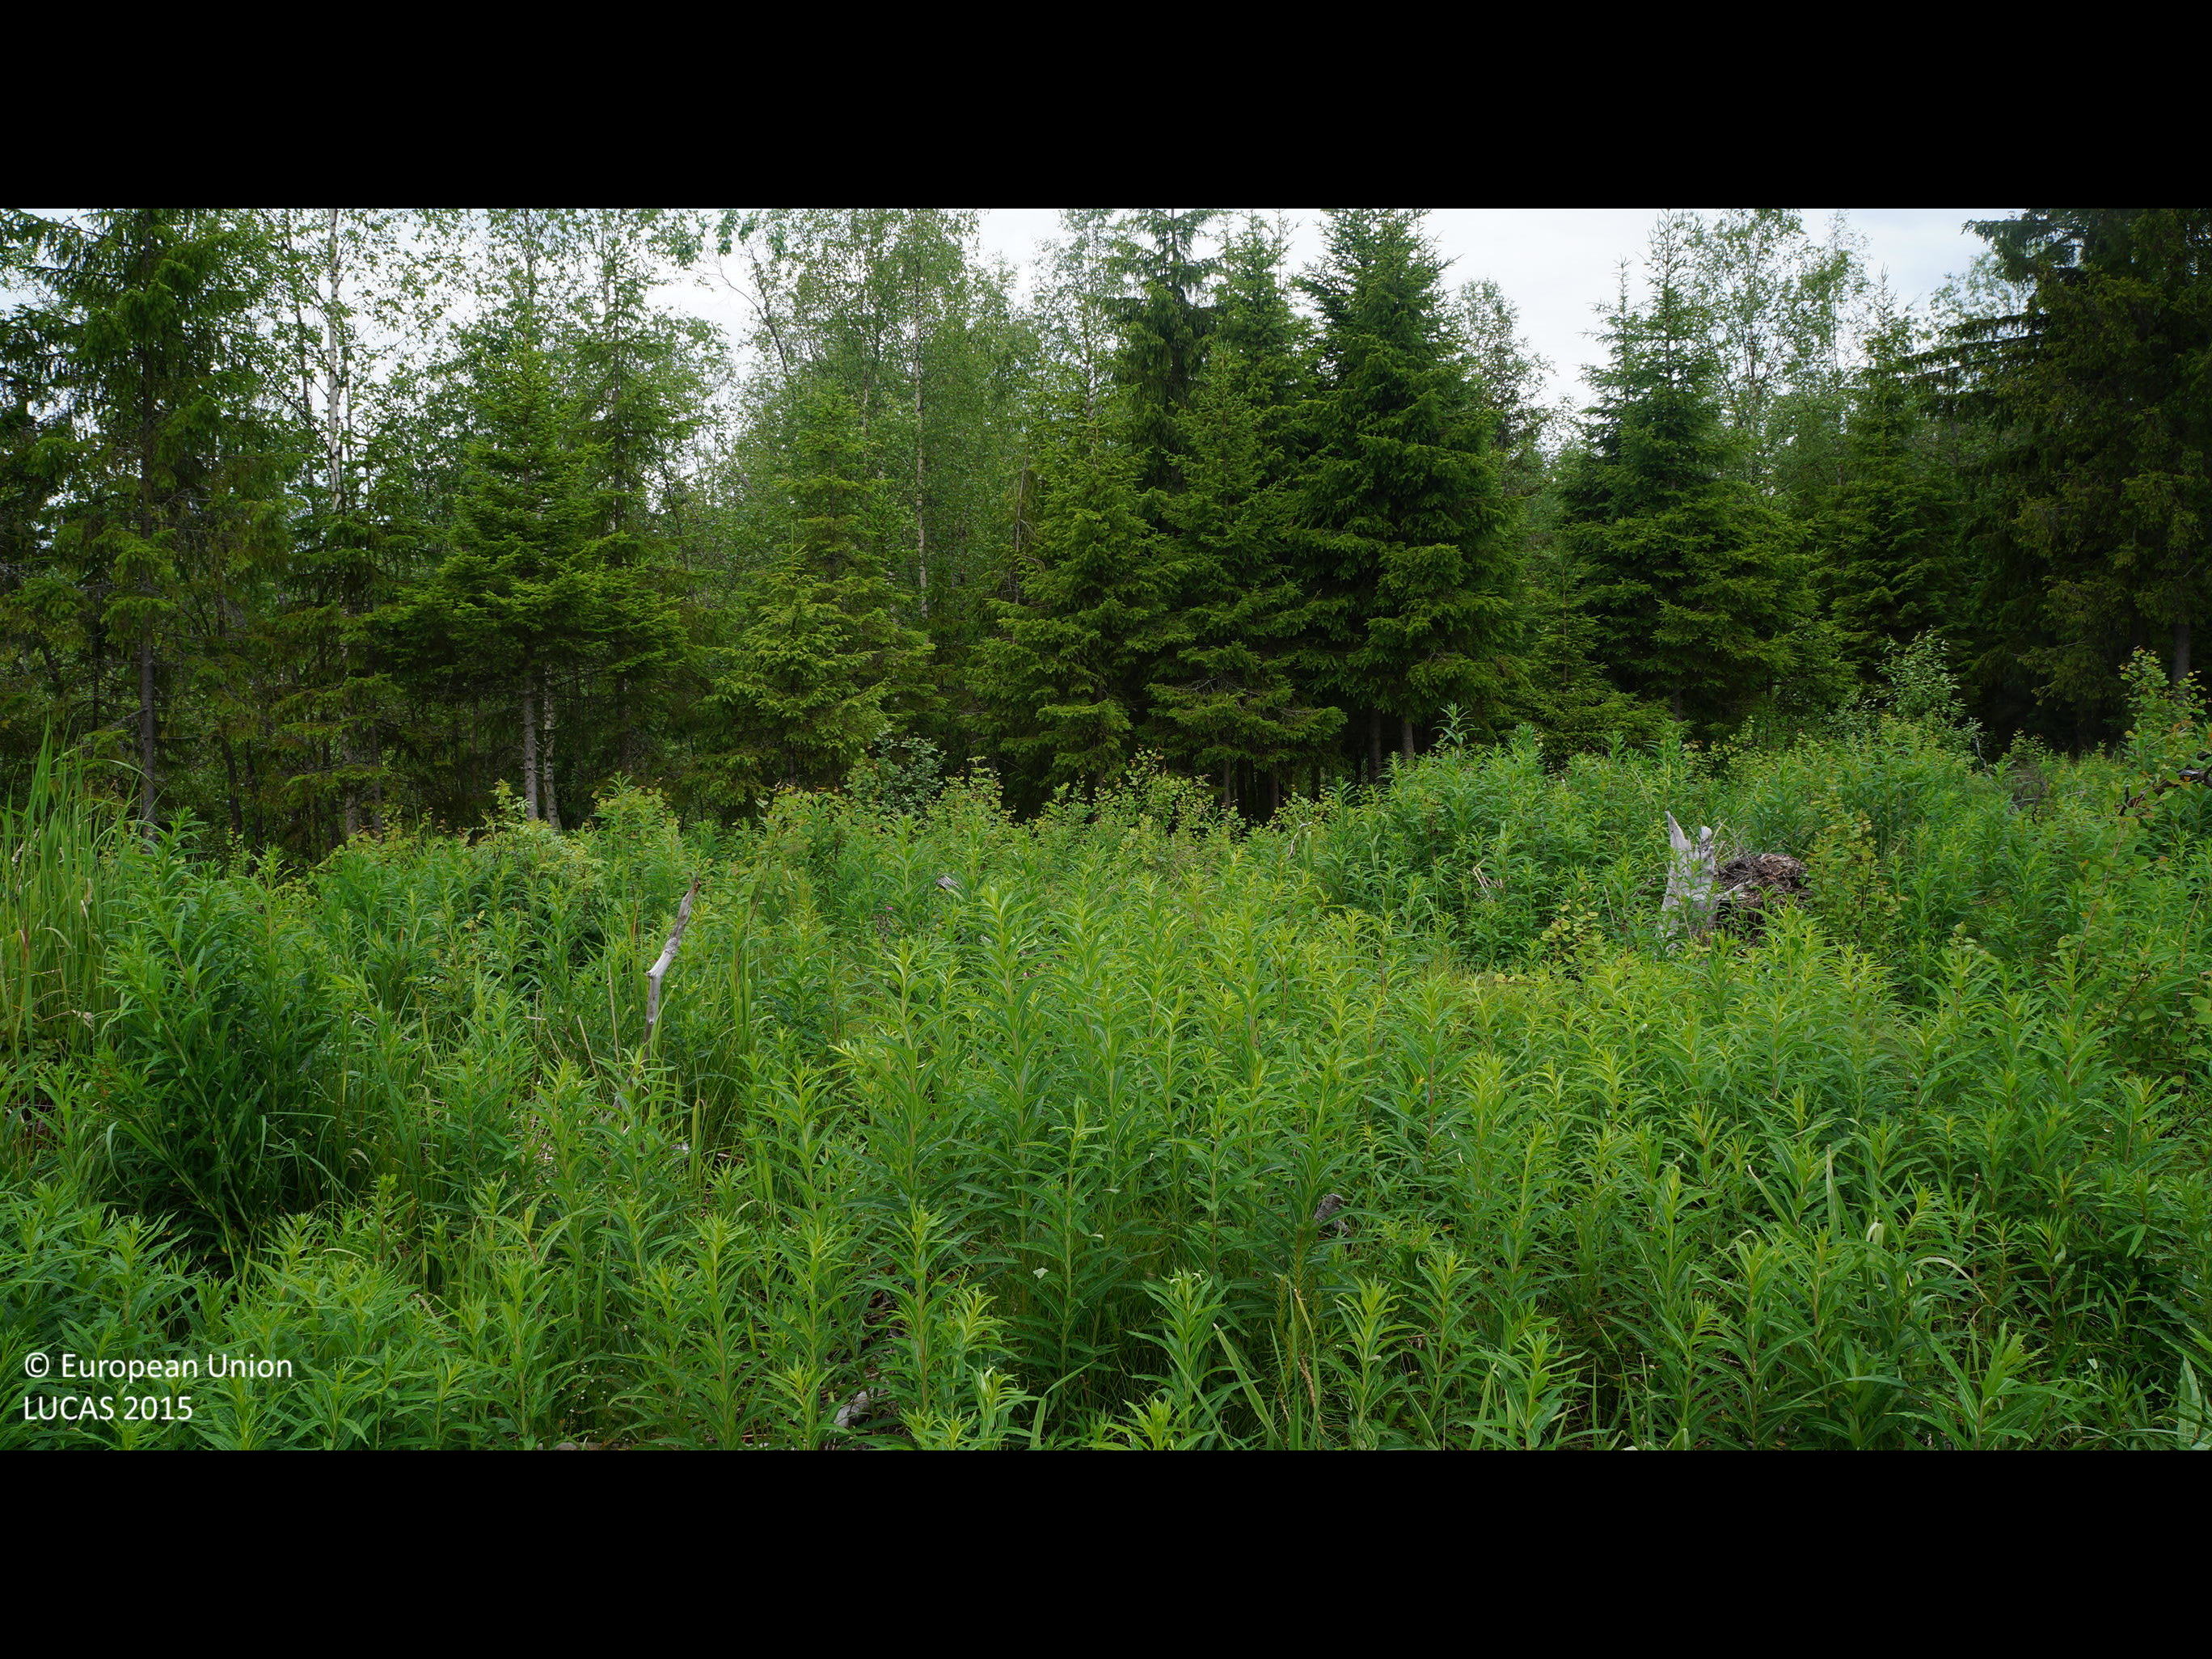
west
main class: Grassland
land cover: Grassland with sparse tree/shrub cover
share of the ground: > 75 %
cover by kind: herbaceous plants 90 %, broadleaved forest trees 5 %, shrubs 5 %
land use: Forestry
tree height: < 5 m
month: July
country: FI
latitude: 64.3508
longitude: 24.3339
